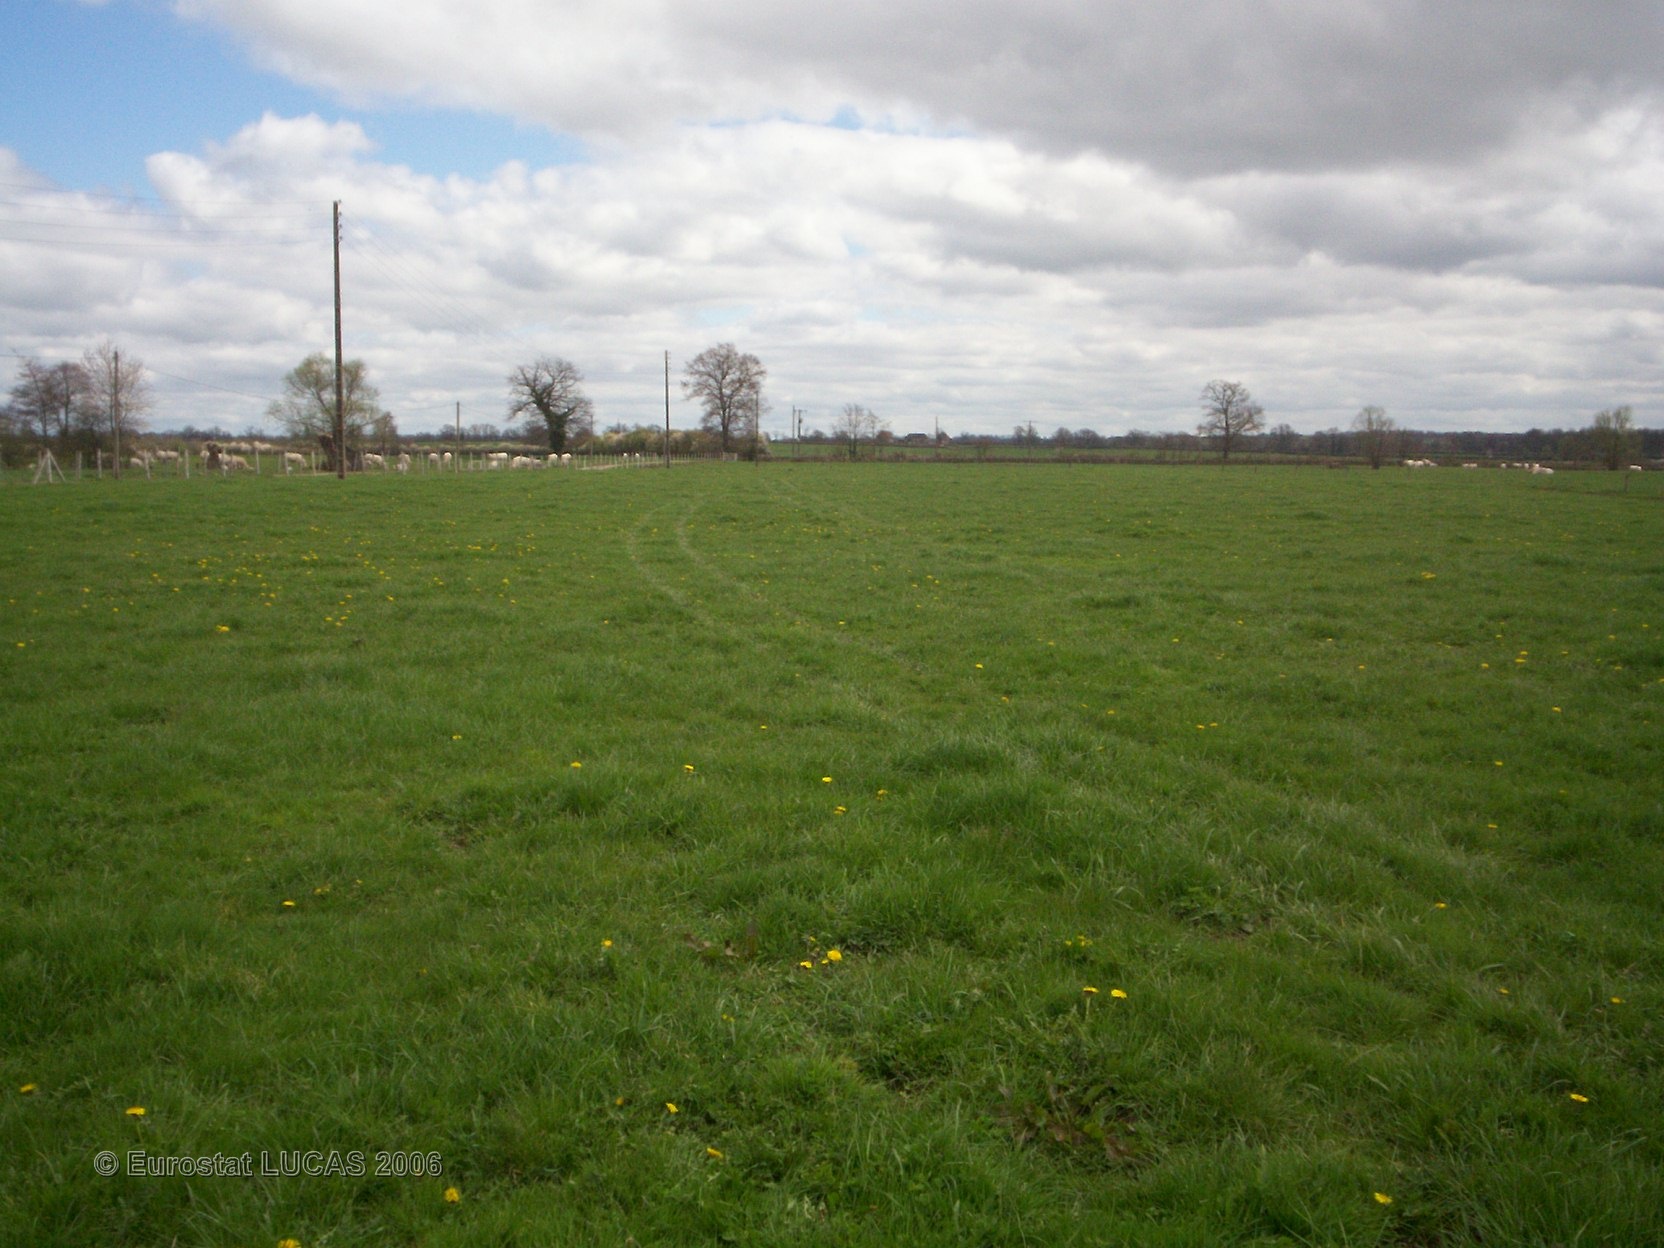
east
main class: Grassland
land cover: Grassland without tree/shrub cover
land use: Agriculture (excluding fallow land and kitchen gardens)
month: April
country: FR
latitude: 46.7931
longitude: 3.0399
